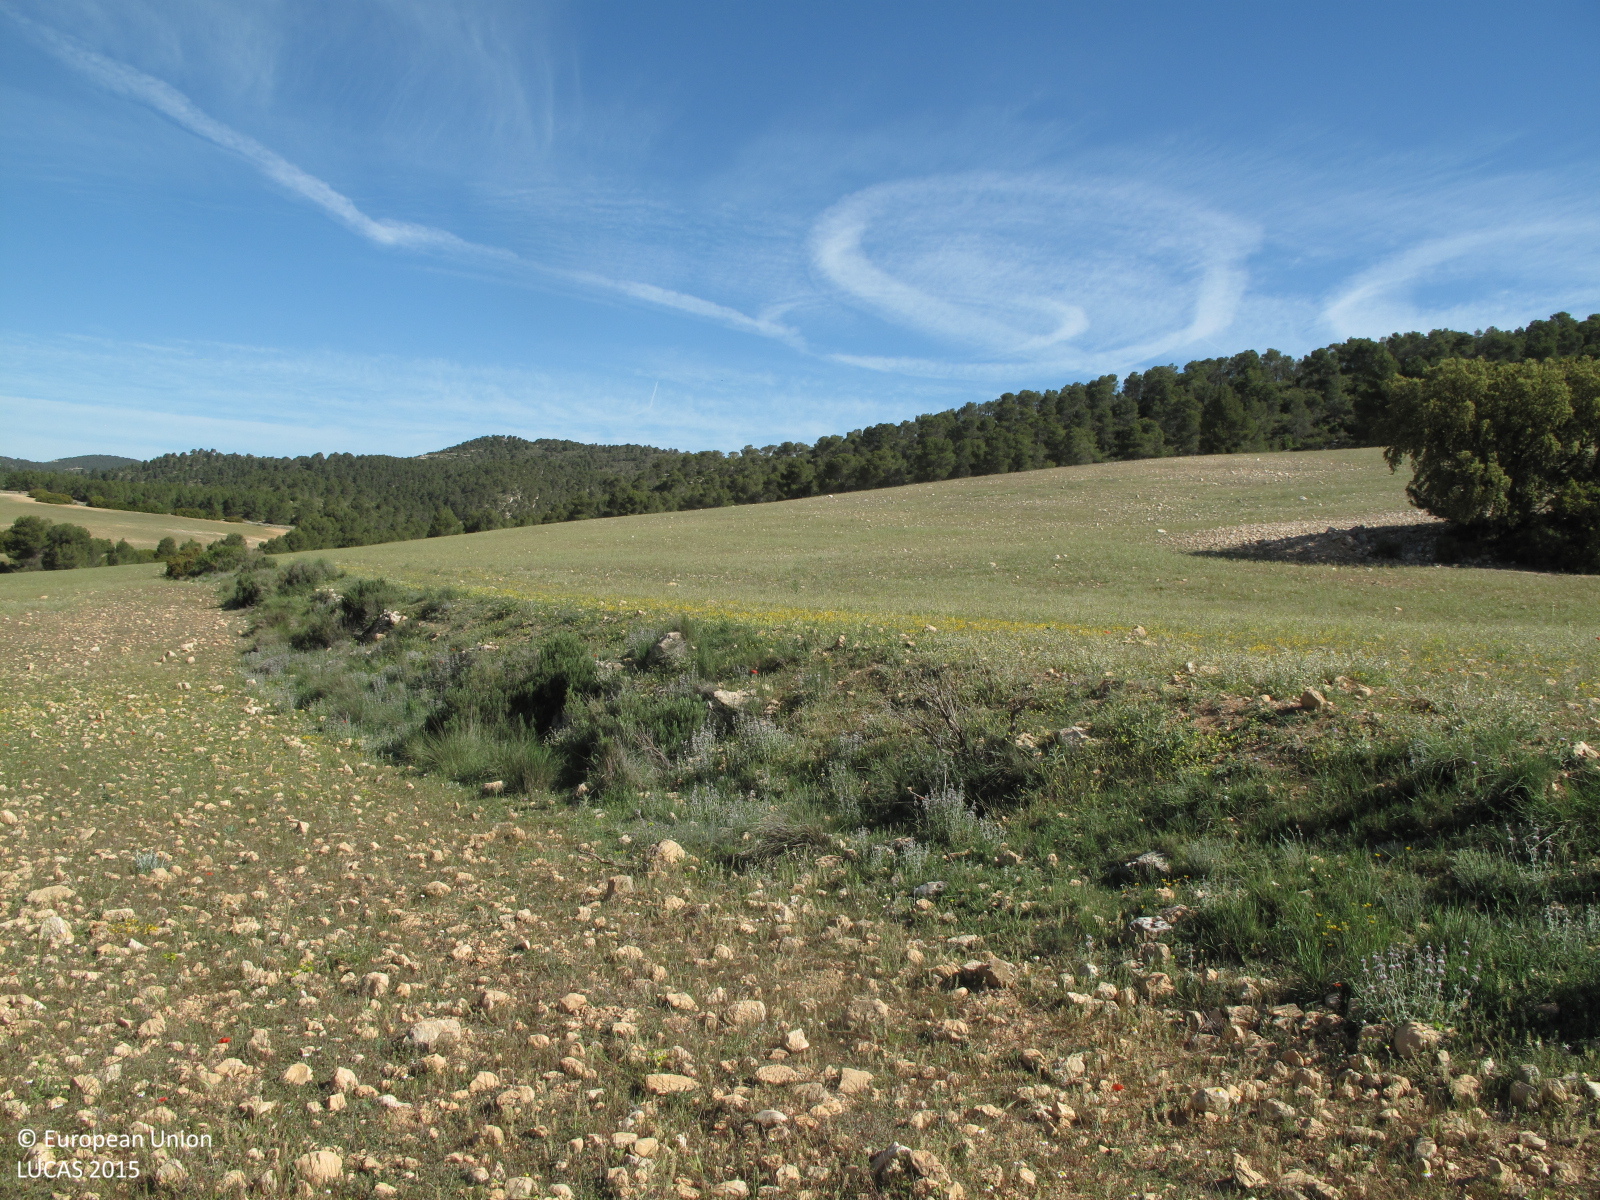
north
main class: Grassland
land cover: Spontaneously vegetated surfaces
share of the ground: 50 - 75 %
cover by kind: herbaceous plants 70 %, unconsolidated bare surface 30 %
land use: Fallow land
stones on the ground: 25 - 50 %
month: May
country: ES
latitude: 38.8978
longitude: -1.0053
